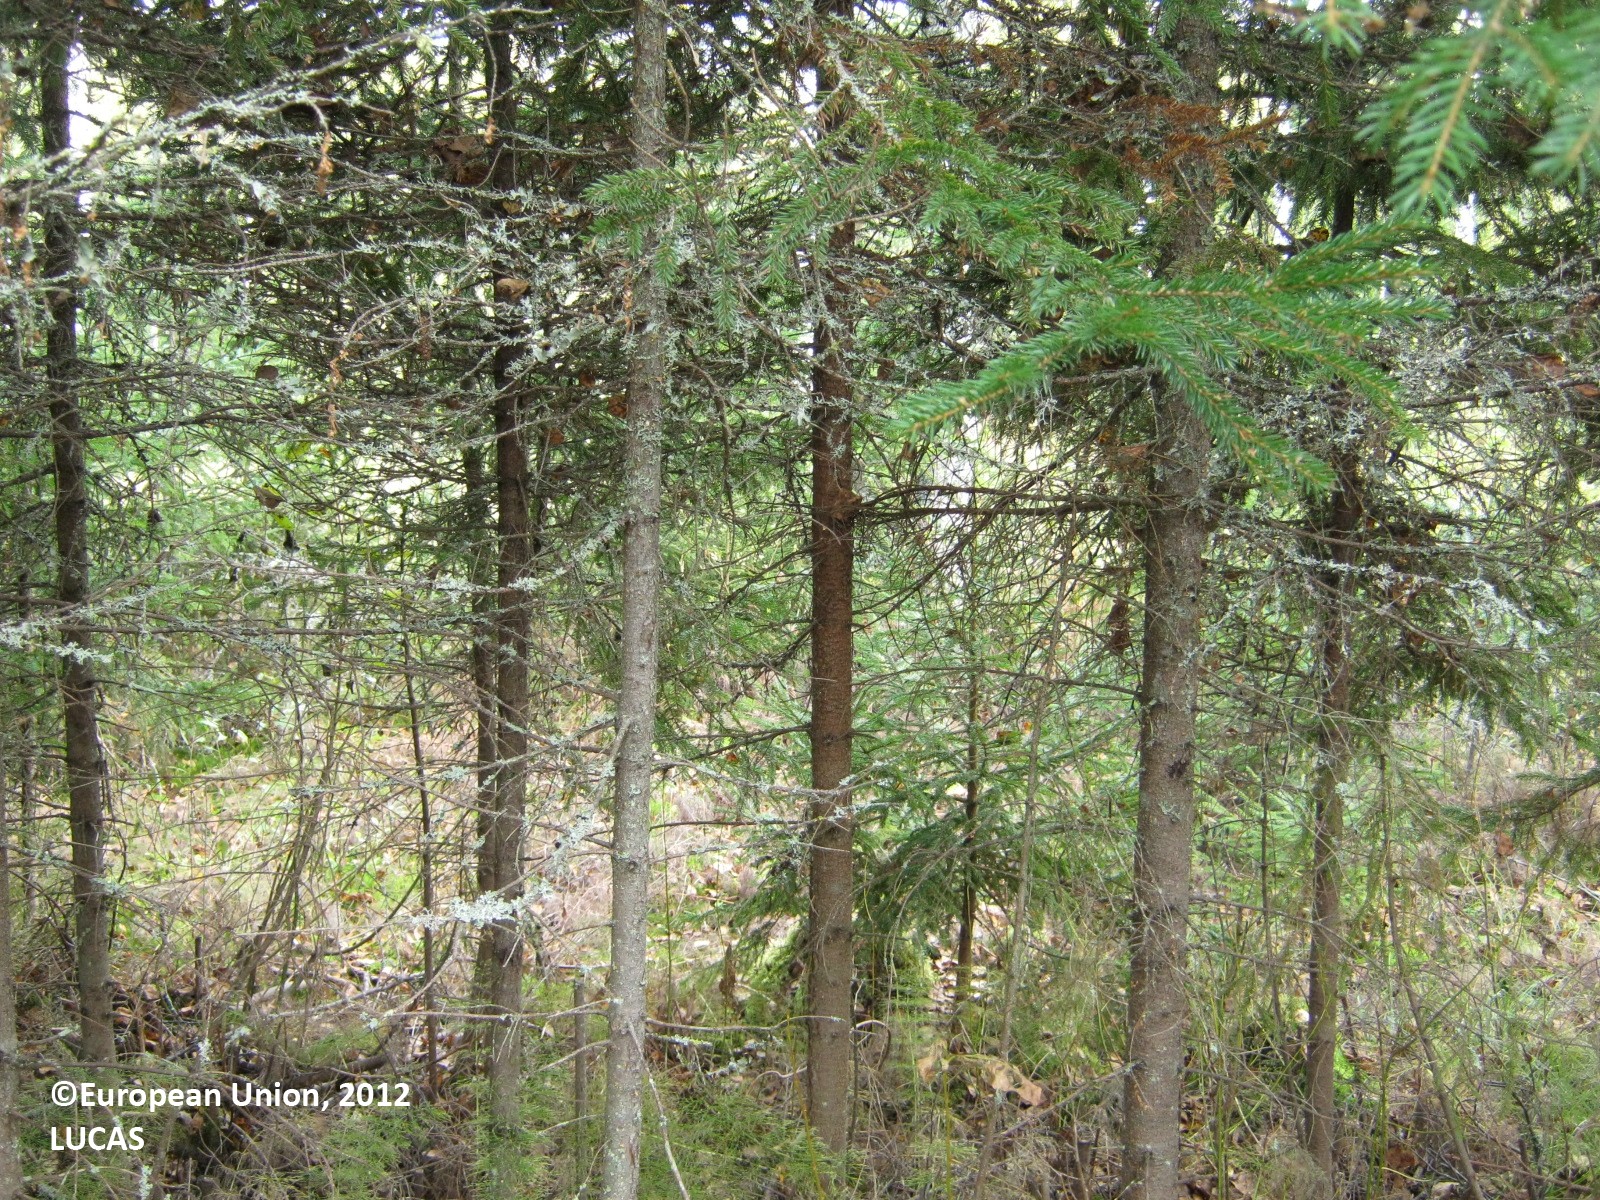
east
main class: Woodland
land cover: Spruce dominated mixed woodland
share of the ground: > 75 %
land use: Forestry
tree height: < 5 m
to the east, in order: Spruce dominated mixed woodland; Ditches and canals; Broadleaved woodland; Spruce dominated mixed woodland; Tracks; Shrubland with sparse tree cover; Pine dominated coniferous woodland; Broadleaved woodland
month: September
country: FI
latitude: 60.9126
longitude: 28.1855
